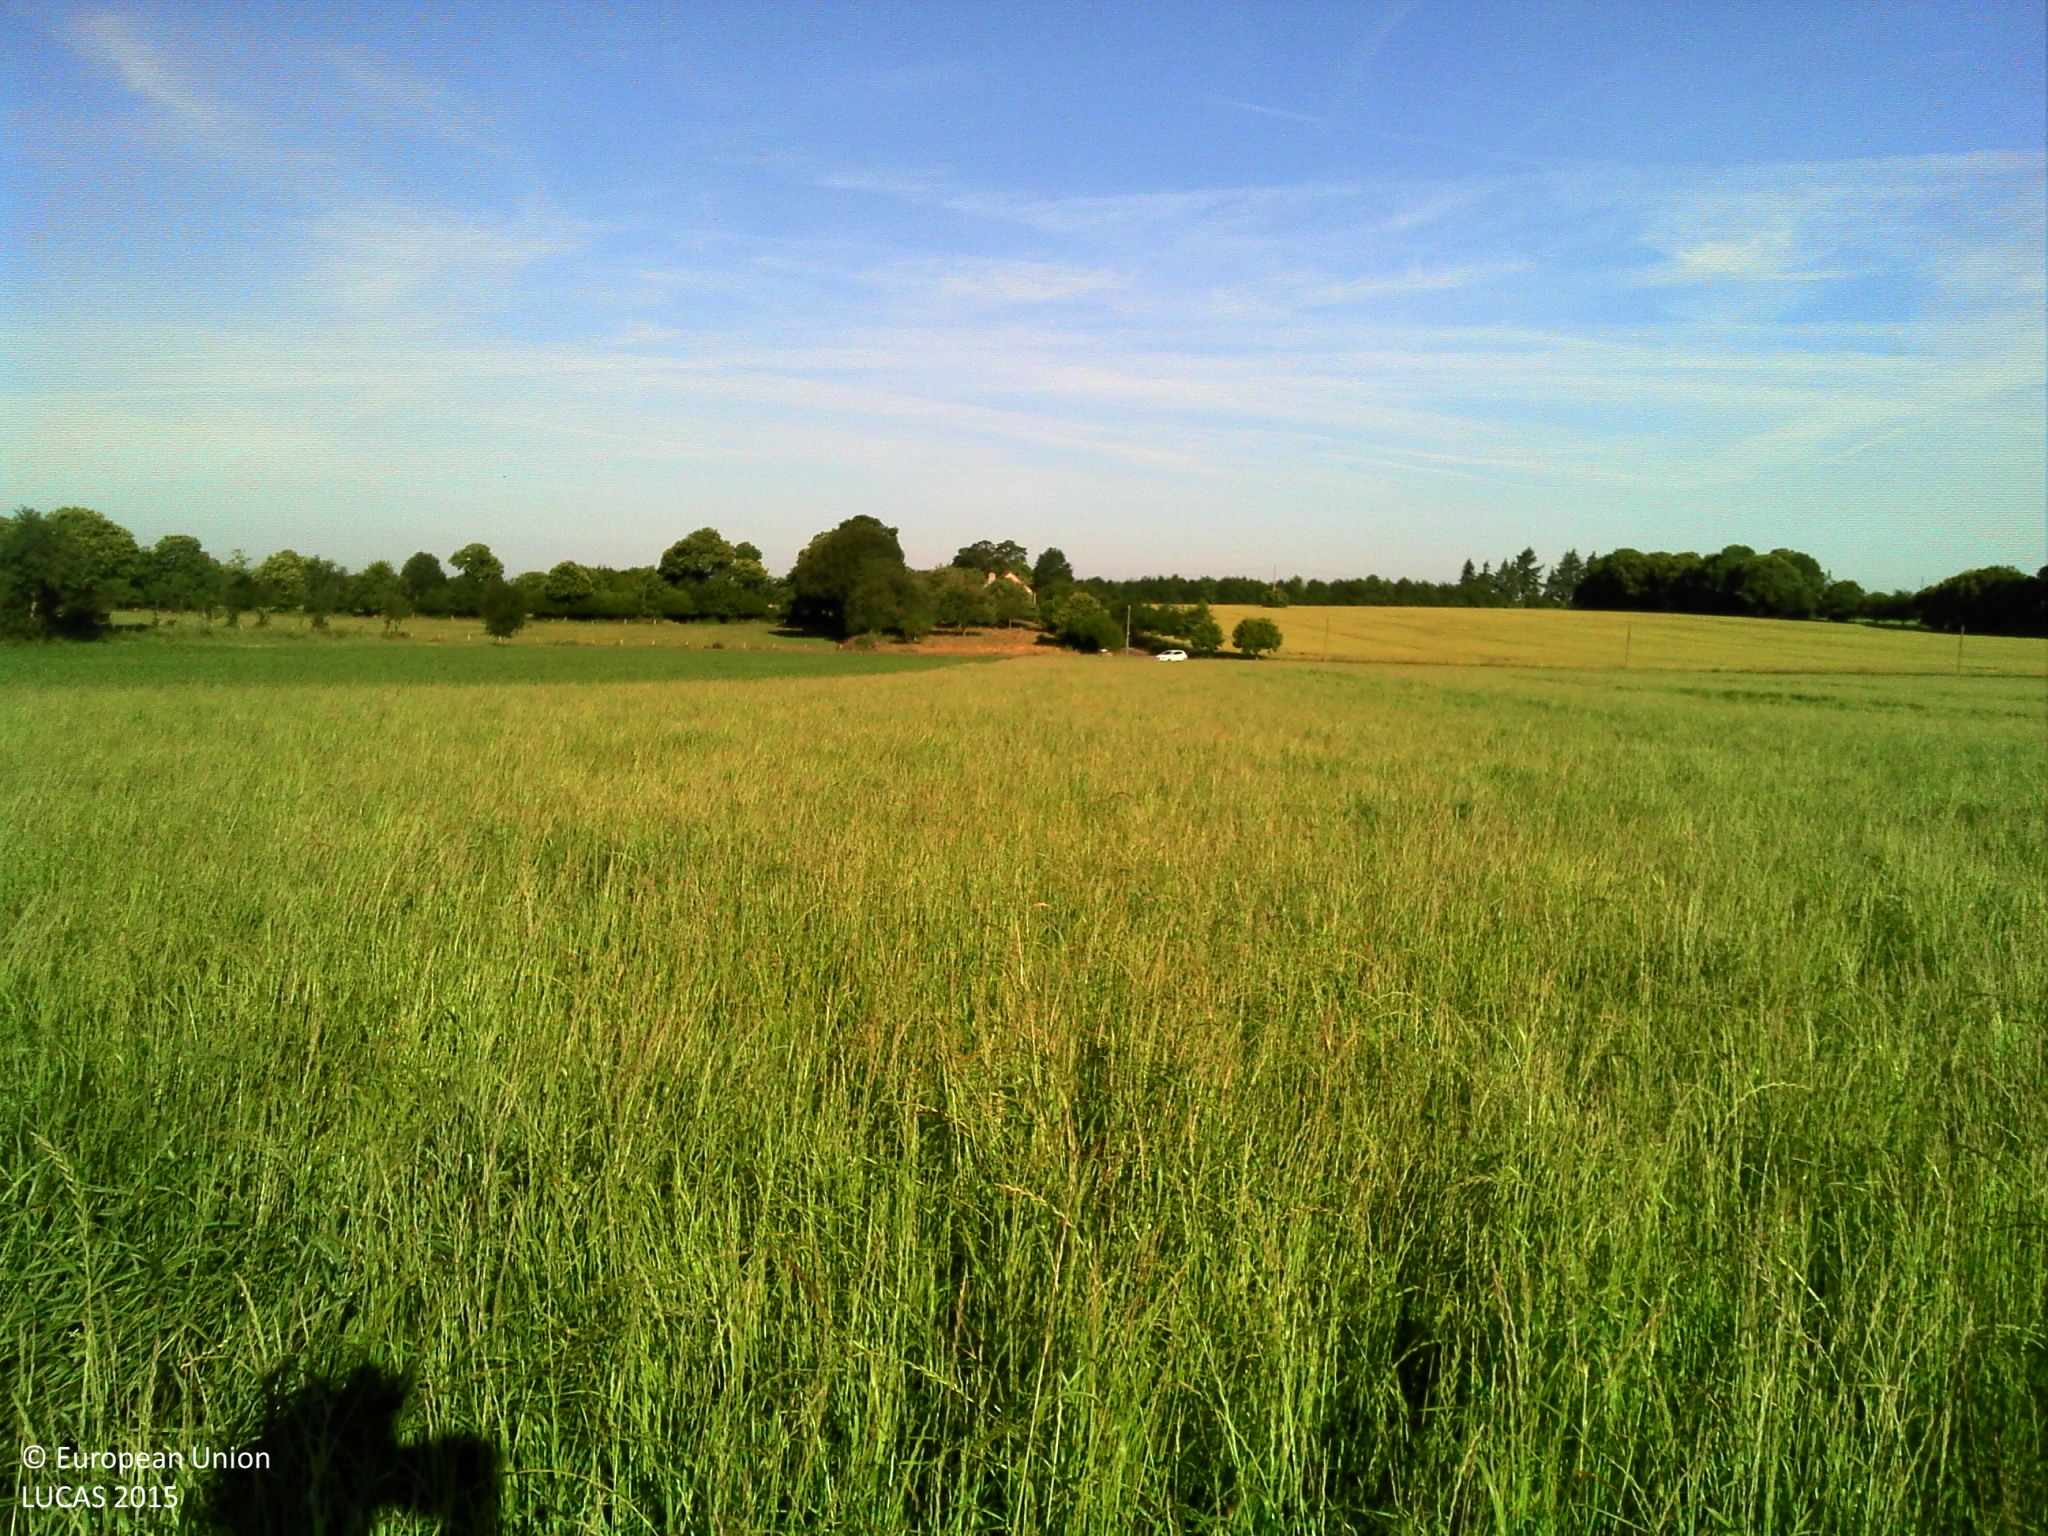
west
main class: Cropland
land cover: Temporary grasslands
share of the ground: > 75 %
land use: Agriculture (excluding fallow land and kitchen gardens)
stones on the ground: < 10 %
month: June
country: FR
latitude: 48.3711
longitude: -1.2616
